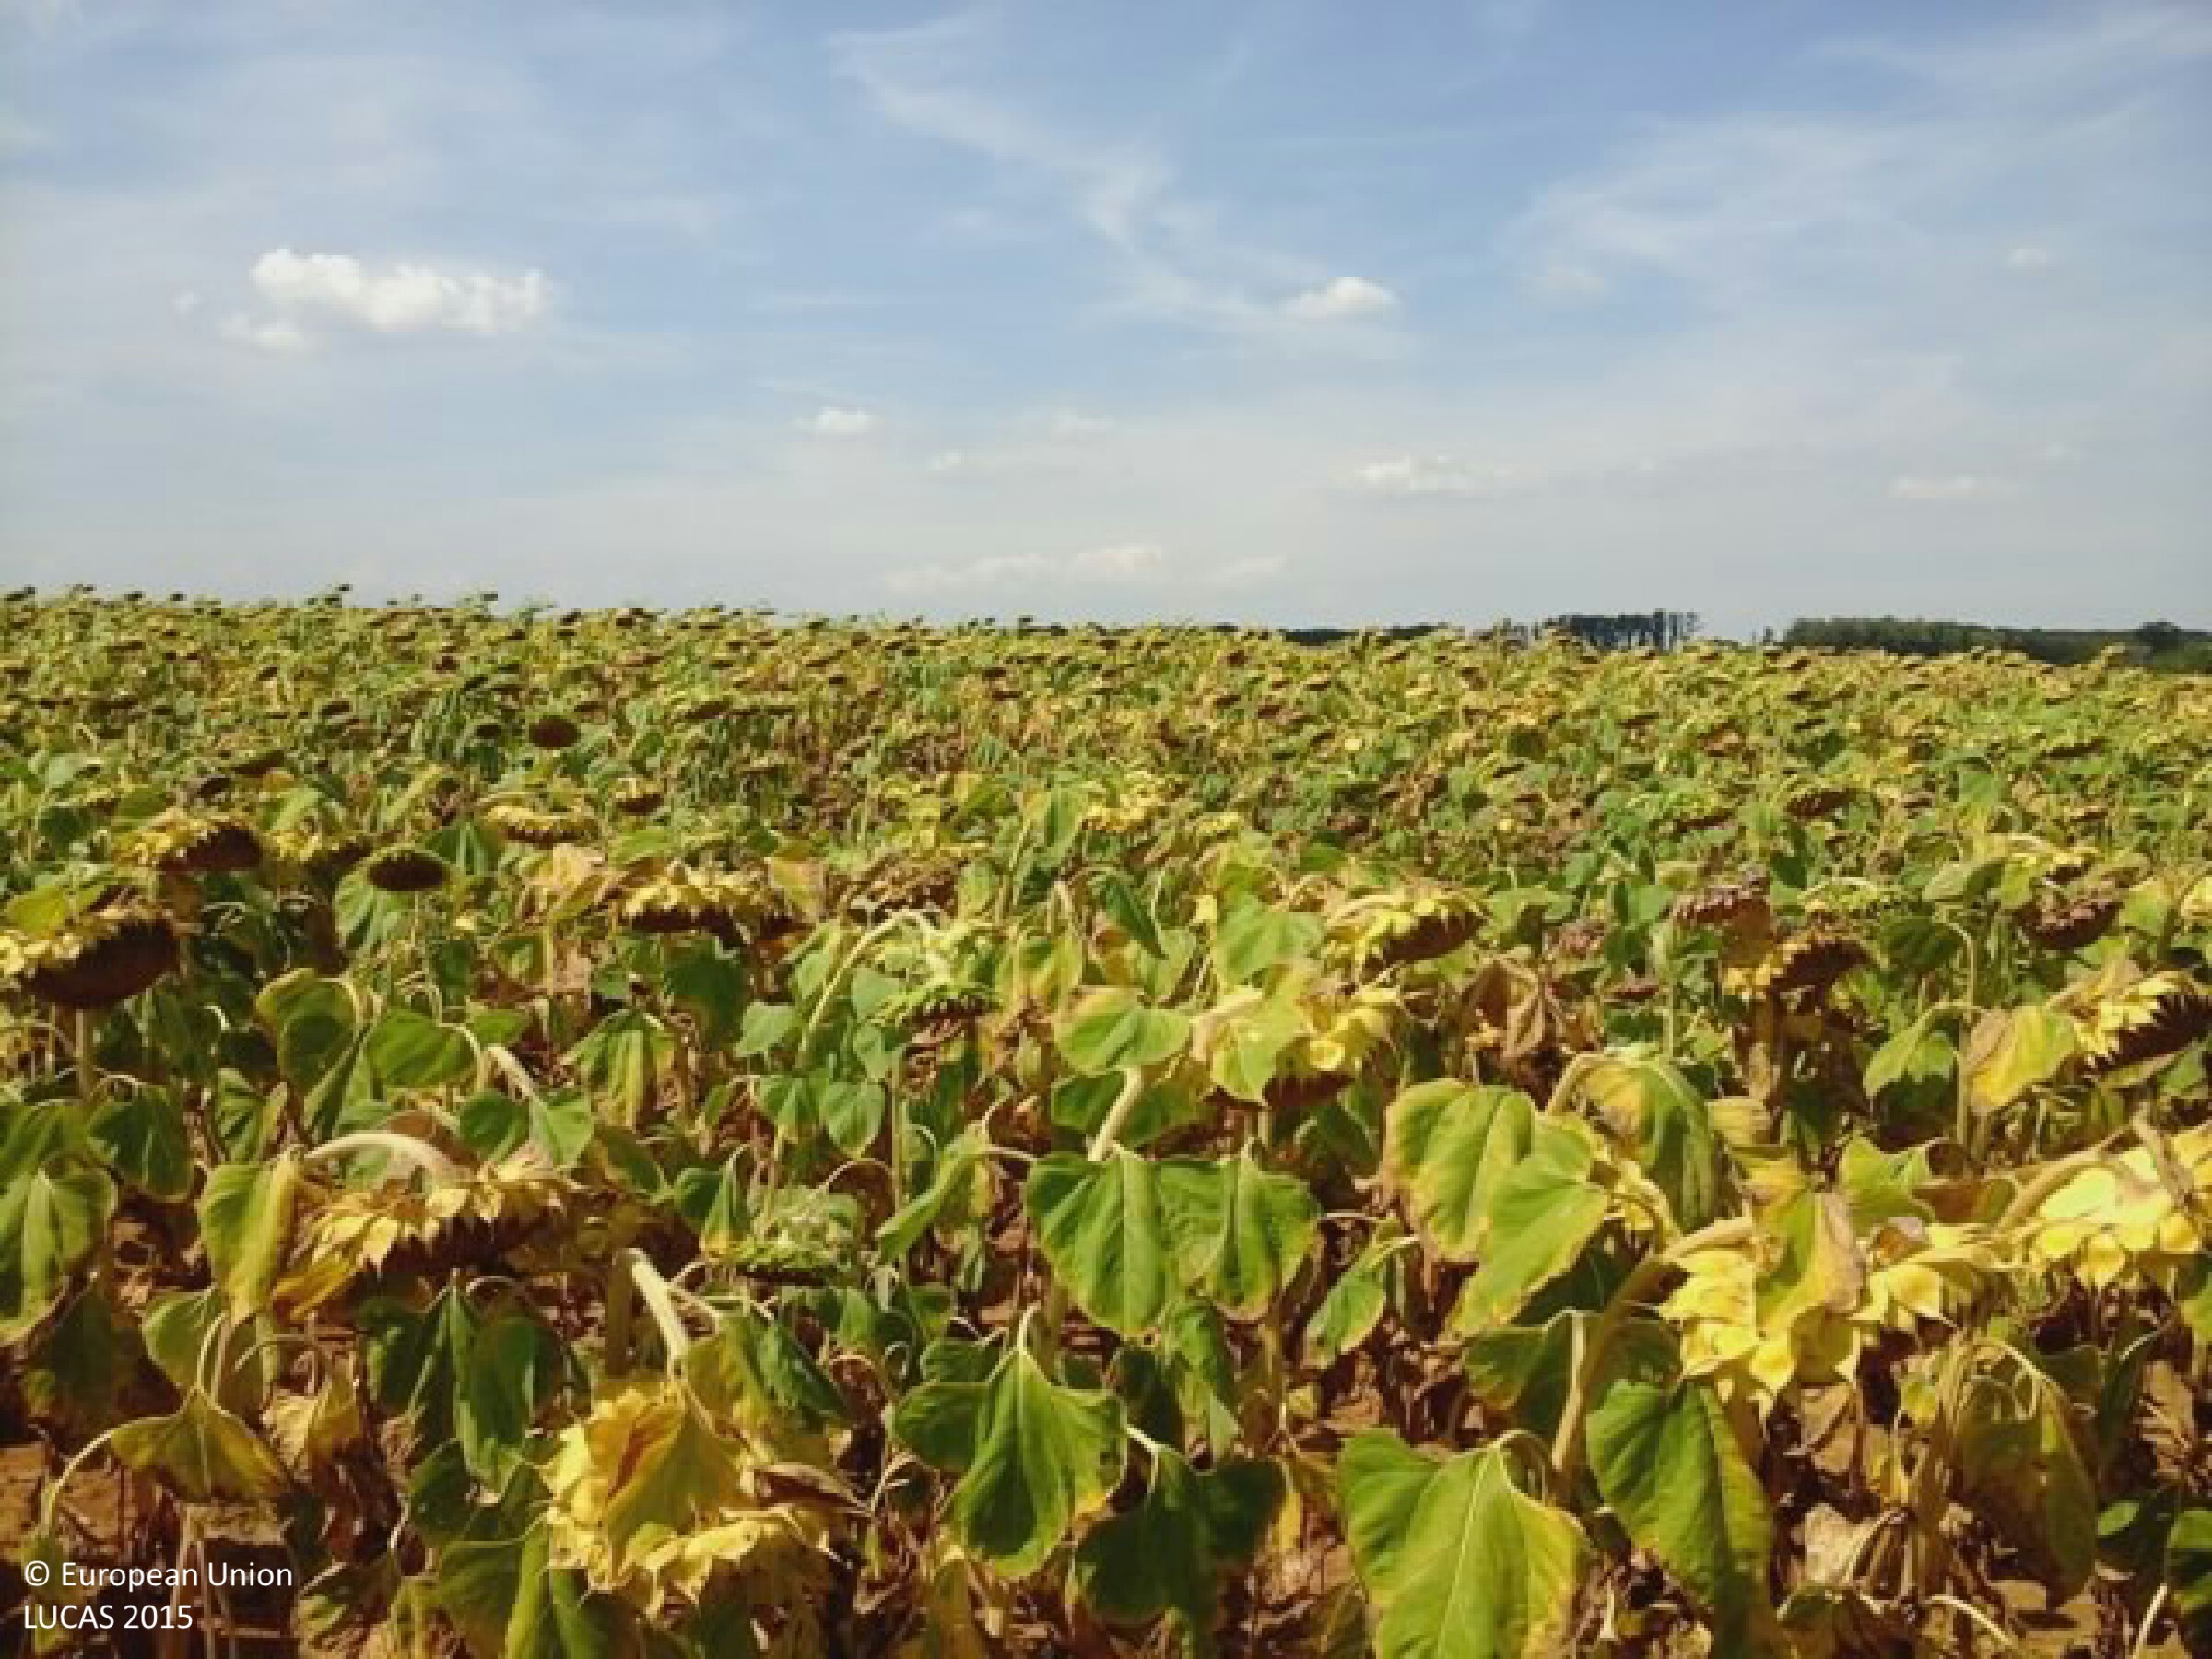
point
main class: Cropland
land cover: Sunflower
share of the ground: > 75 %
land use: Agriculture (excluding fallow land and kitchen gardens)
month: August
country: HU
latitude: 46.5518
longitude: 18.0814
